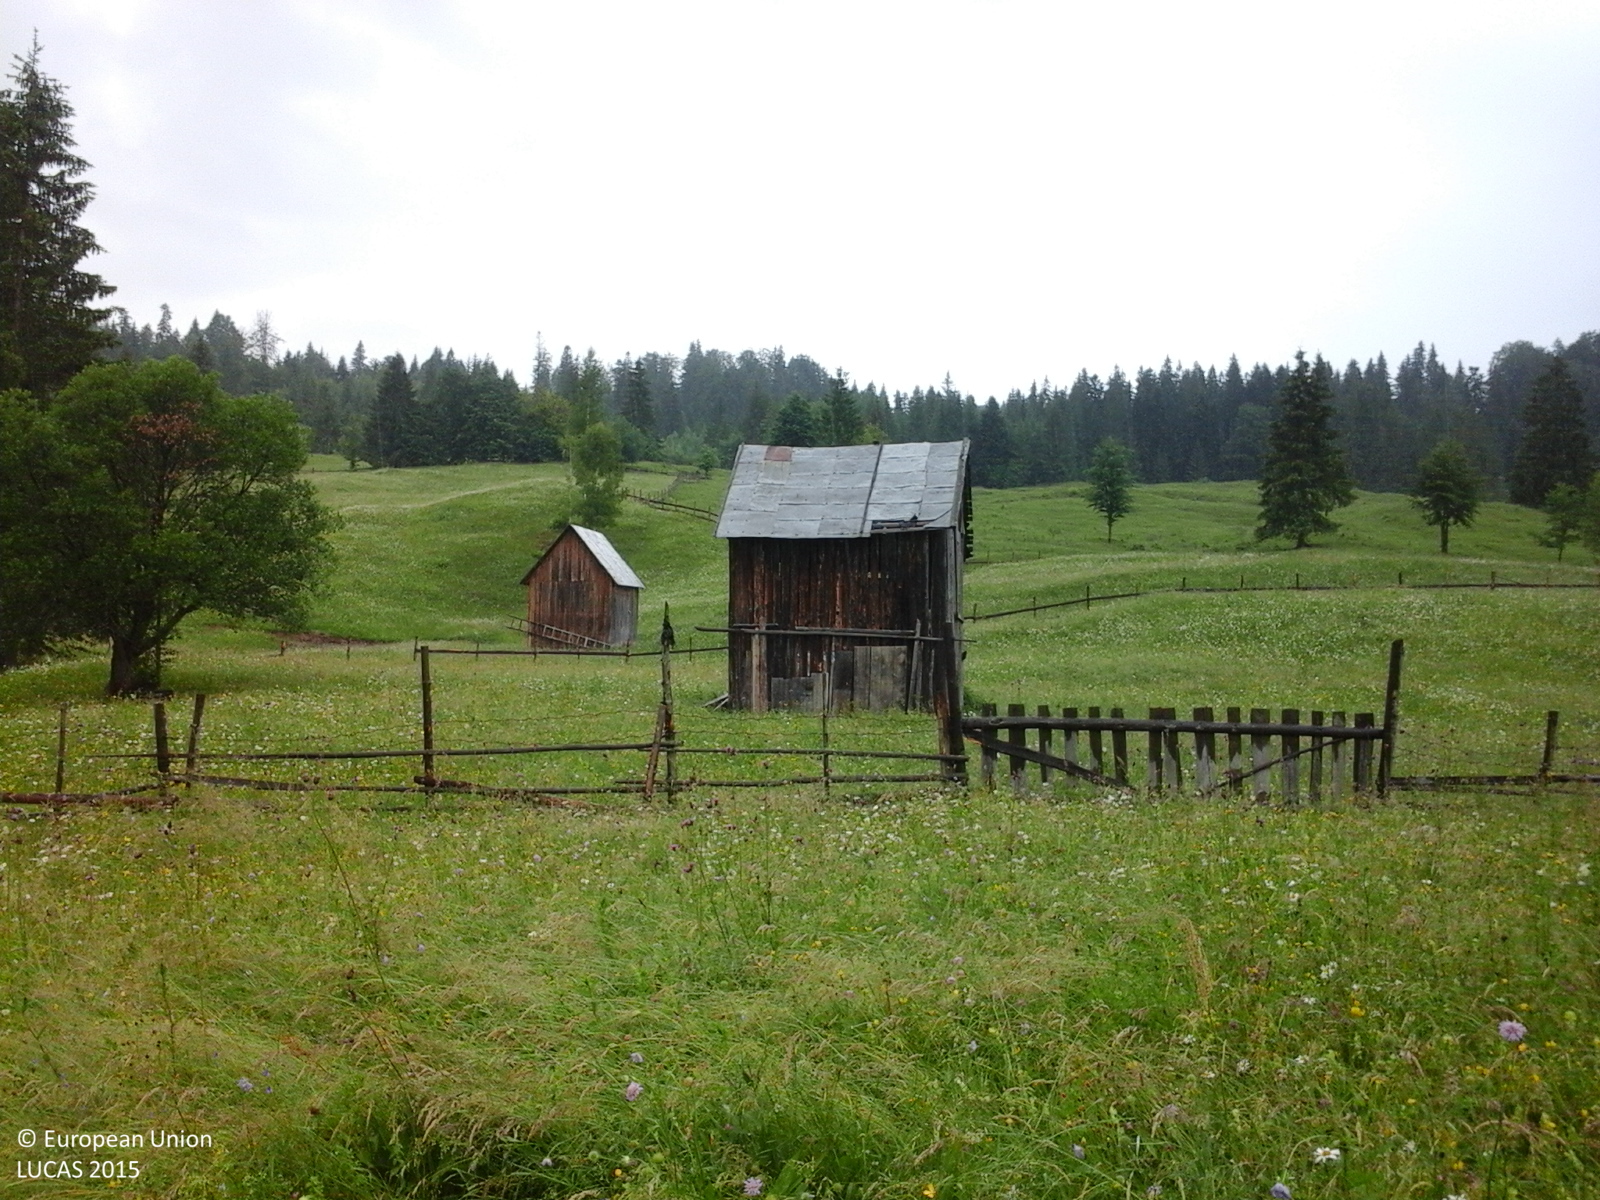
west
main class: Grassland
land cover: Grassland without tree/shrub cover
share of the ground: > 75 %
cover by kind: herbaceous plants 100 %
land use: Agriculture (excluding fallow land and kitchen gardens)
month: June
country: RO
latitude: 47.4991
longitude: 25.5290
